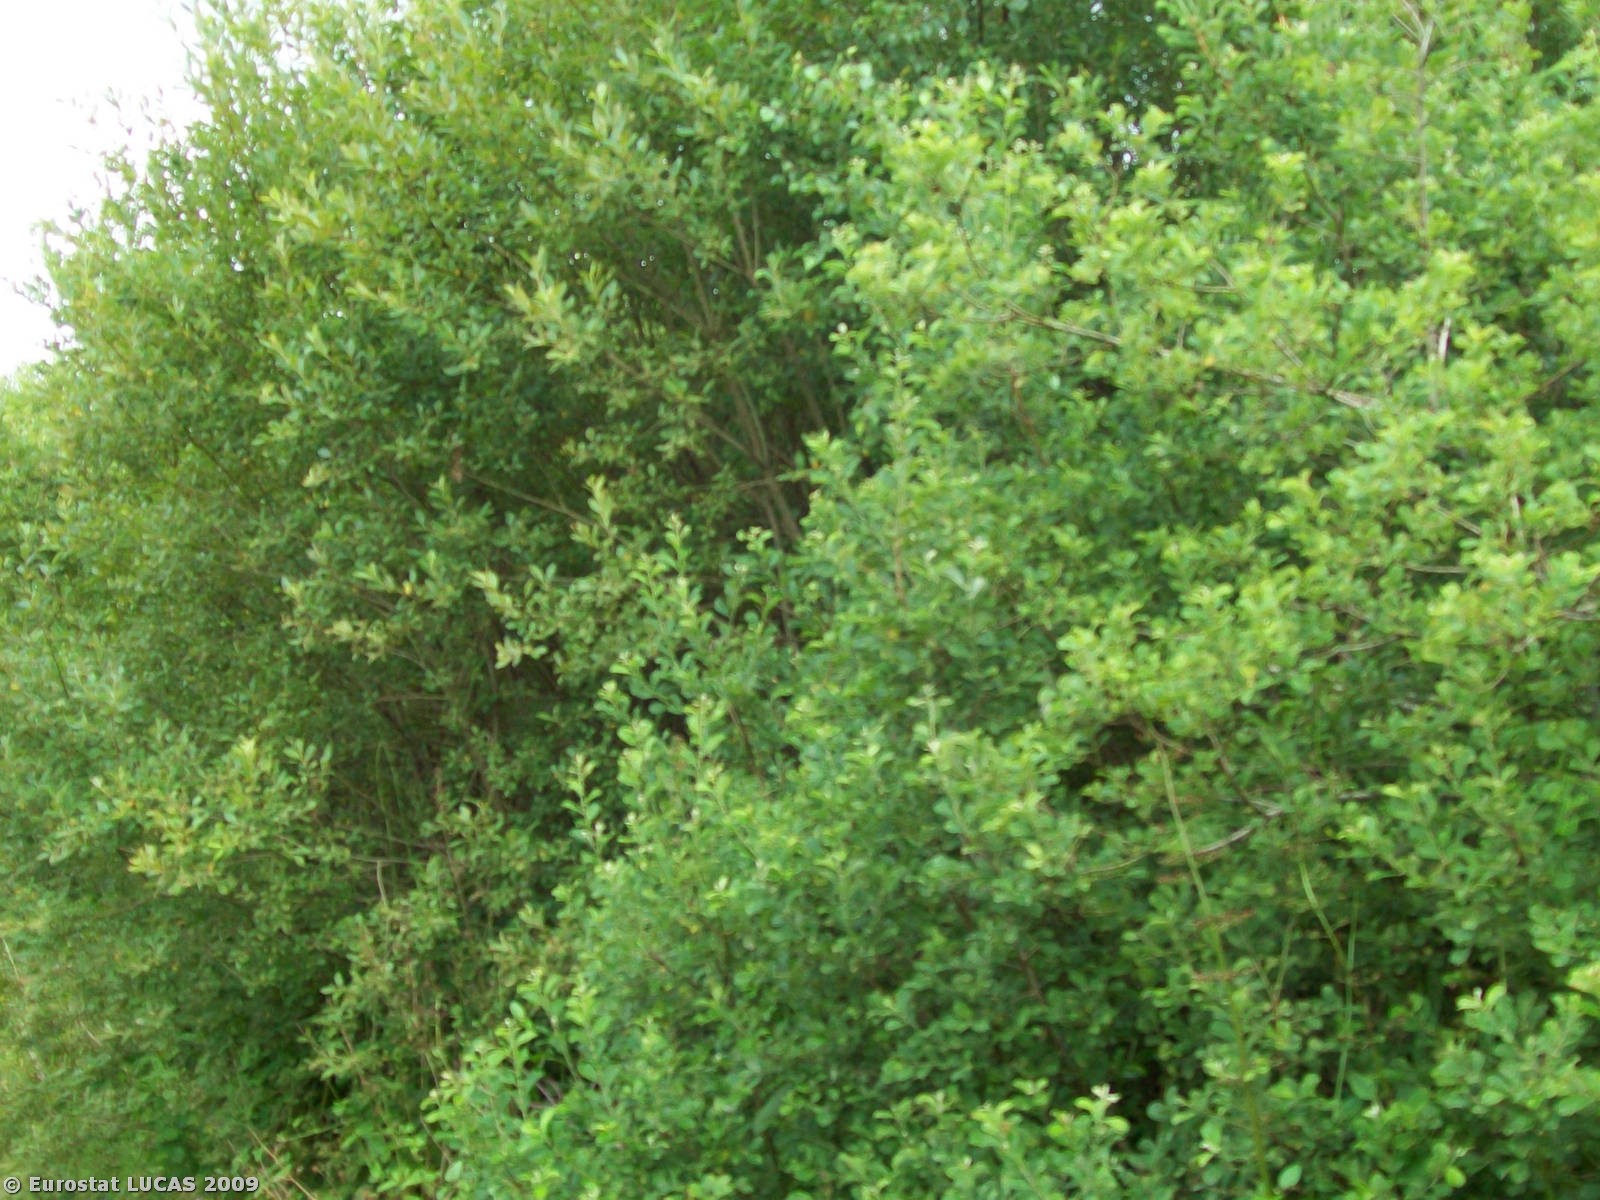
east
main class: Woodland
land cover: Mixed woodland
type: hemiboreal forest and nemoral coniferous forest and mixed broadleaved-coniferous forest
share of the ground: > 75 %
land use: Forestry
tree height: > 5 m
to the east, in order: Mixed woodland; Tracks; Mixed woodland
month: July
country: IE
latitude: 53.6600
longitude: -8.9598
